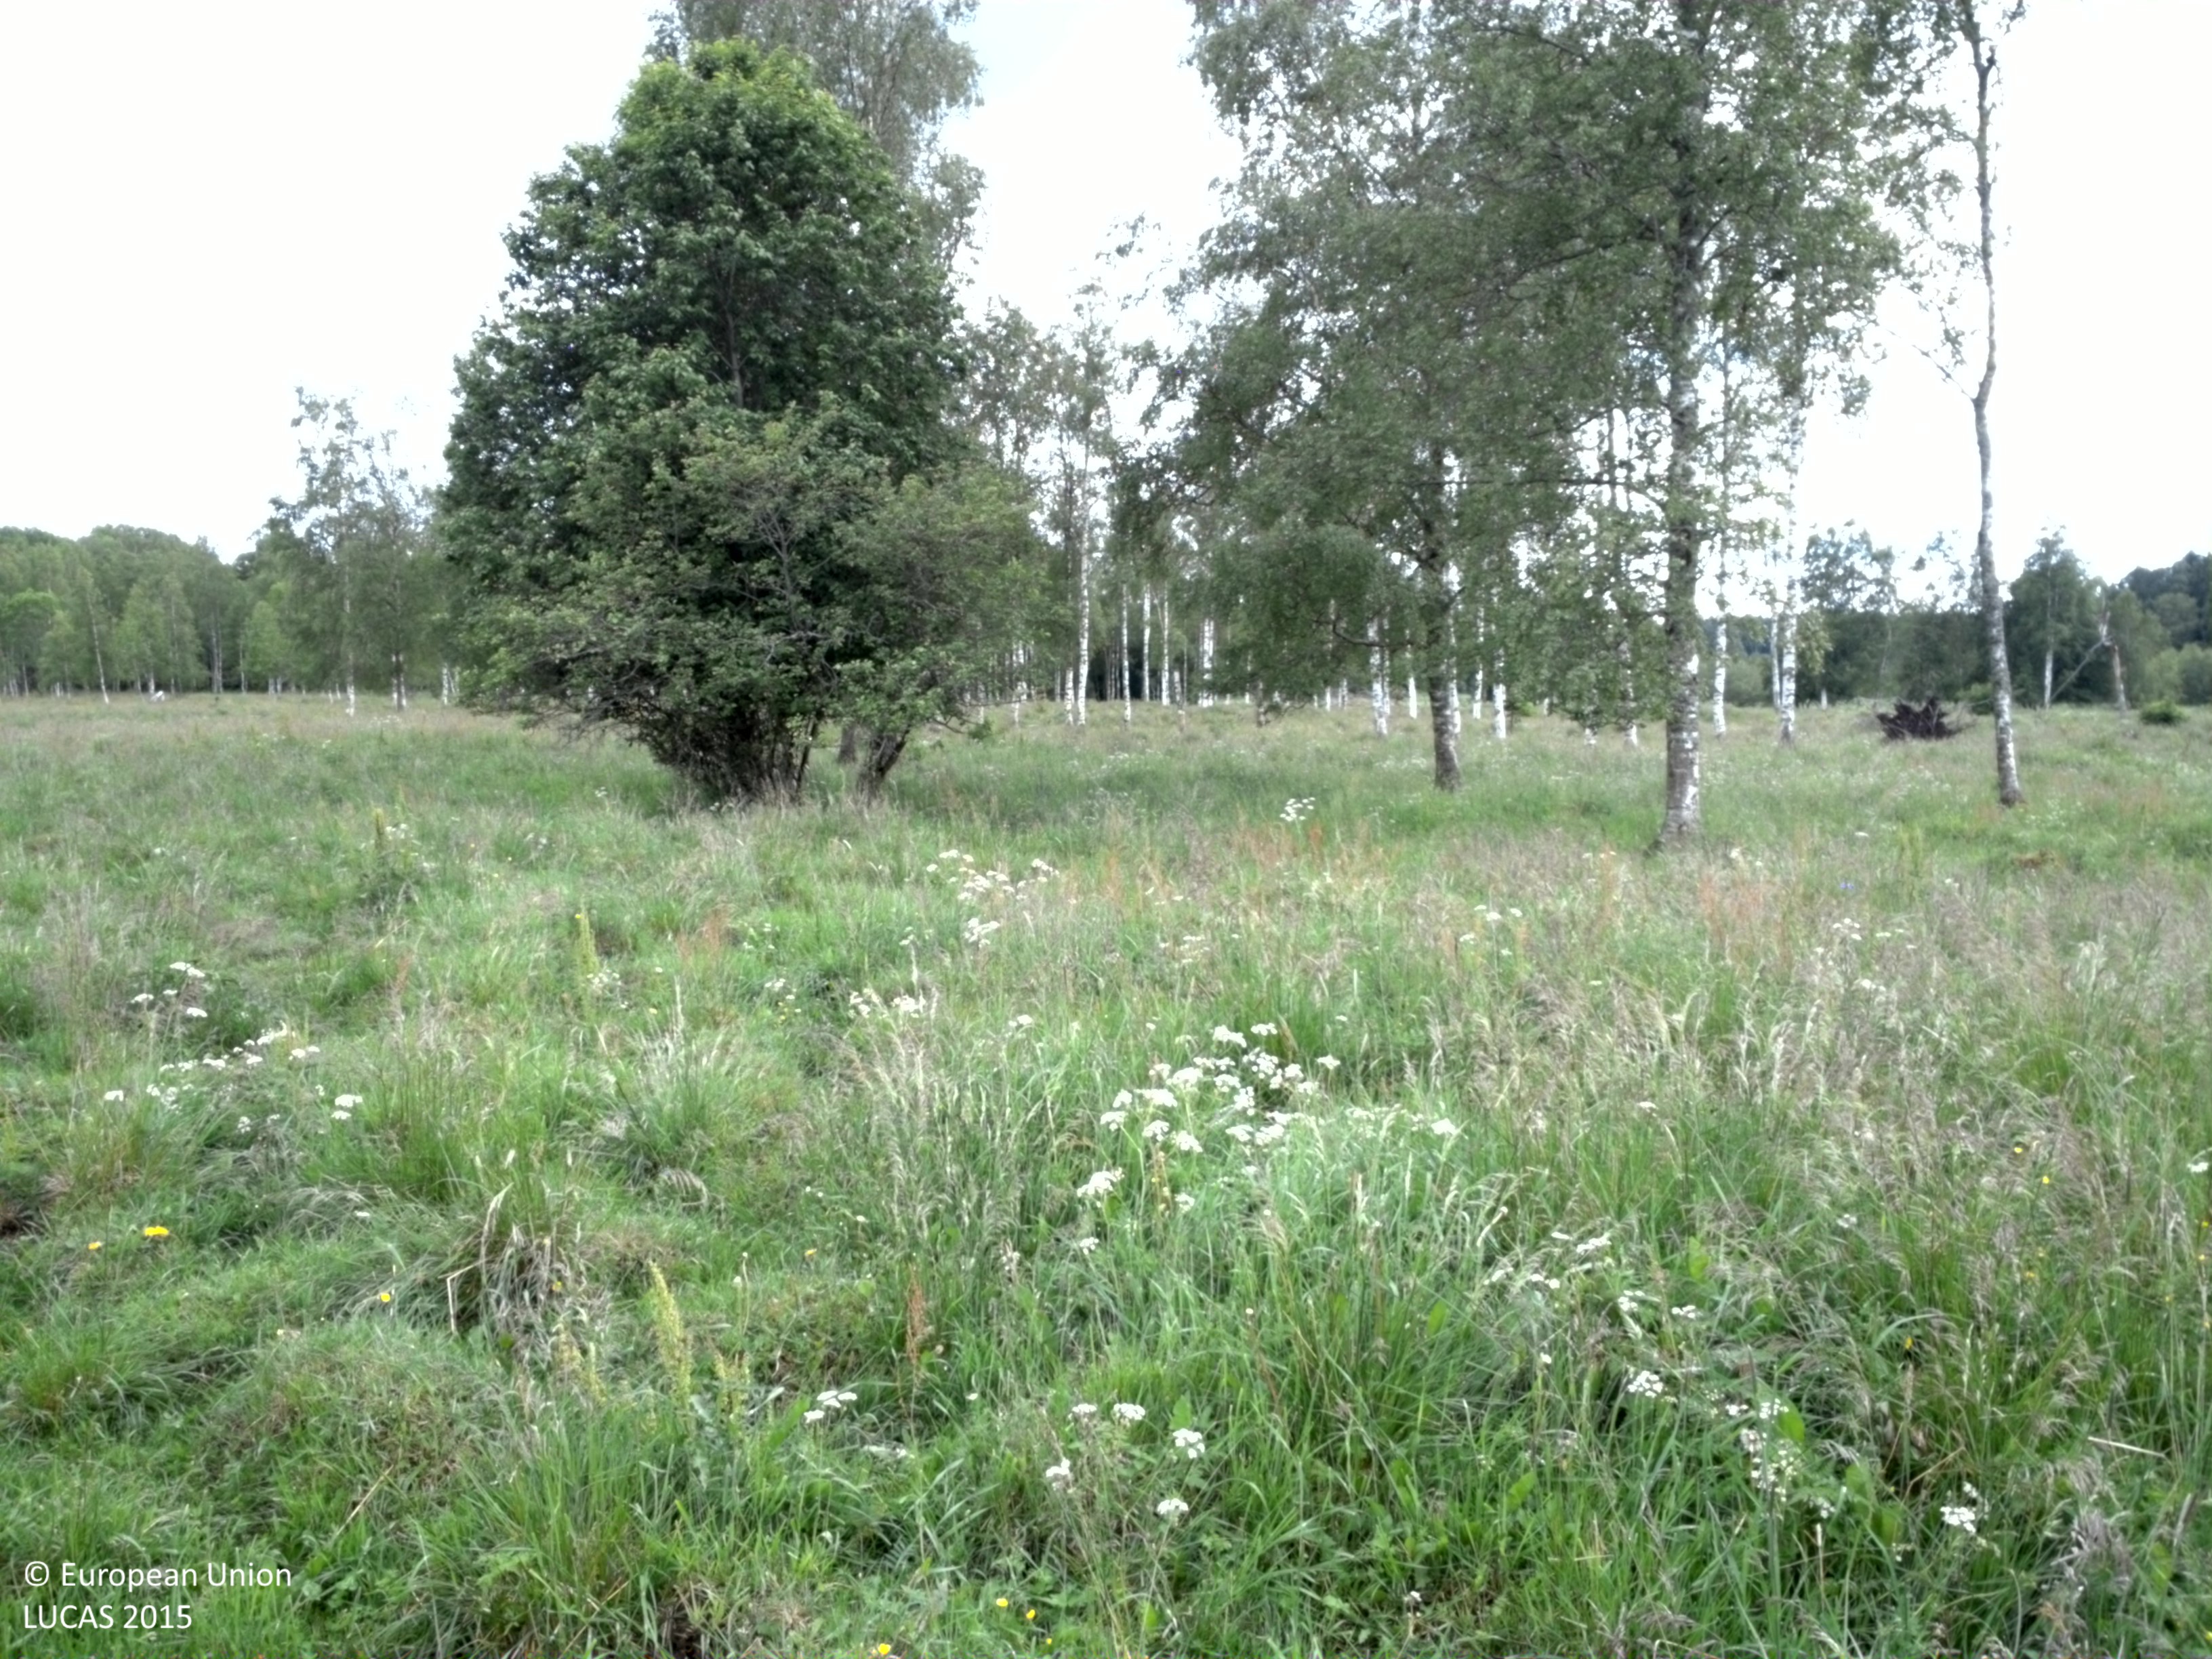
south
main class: Grassland
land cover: Grassland without tree/shrub cover
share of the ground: > 75 %
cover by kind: herbaceous plants 100 %
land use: Agriculture (excluding fallow land and kitchen gardens)
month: June
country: SE
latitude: 59.8617
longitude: 17.0096
